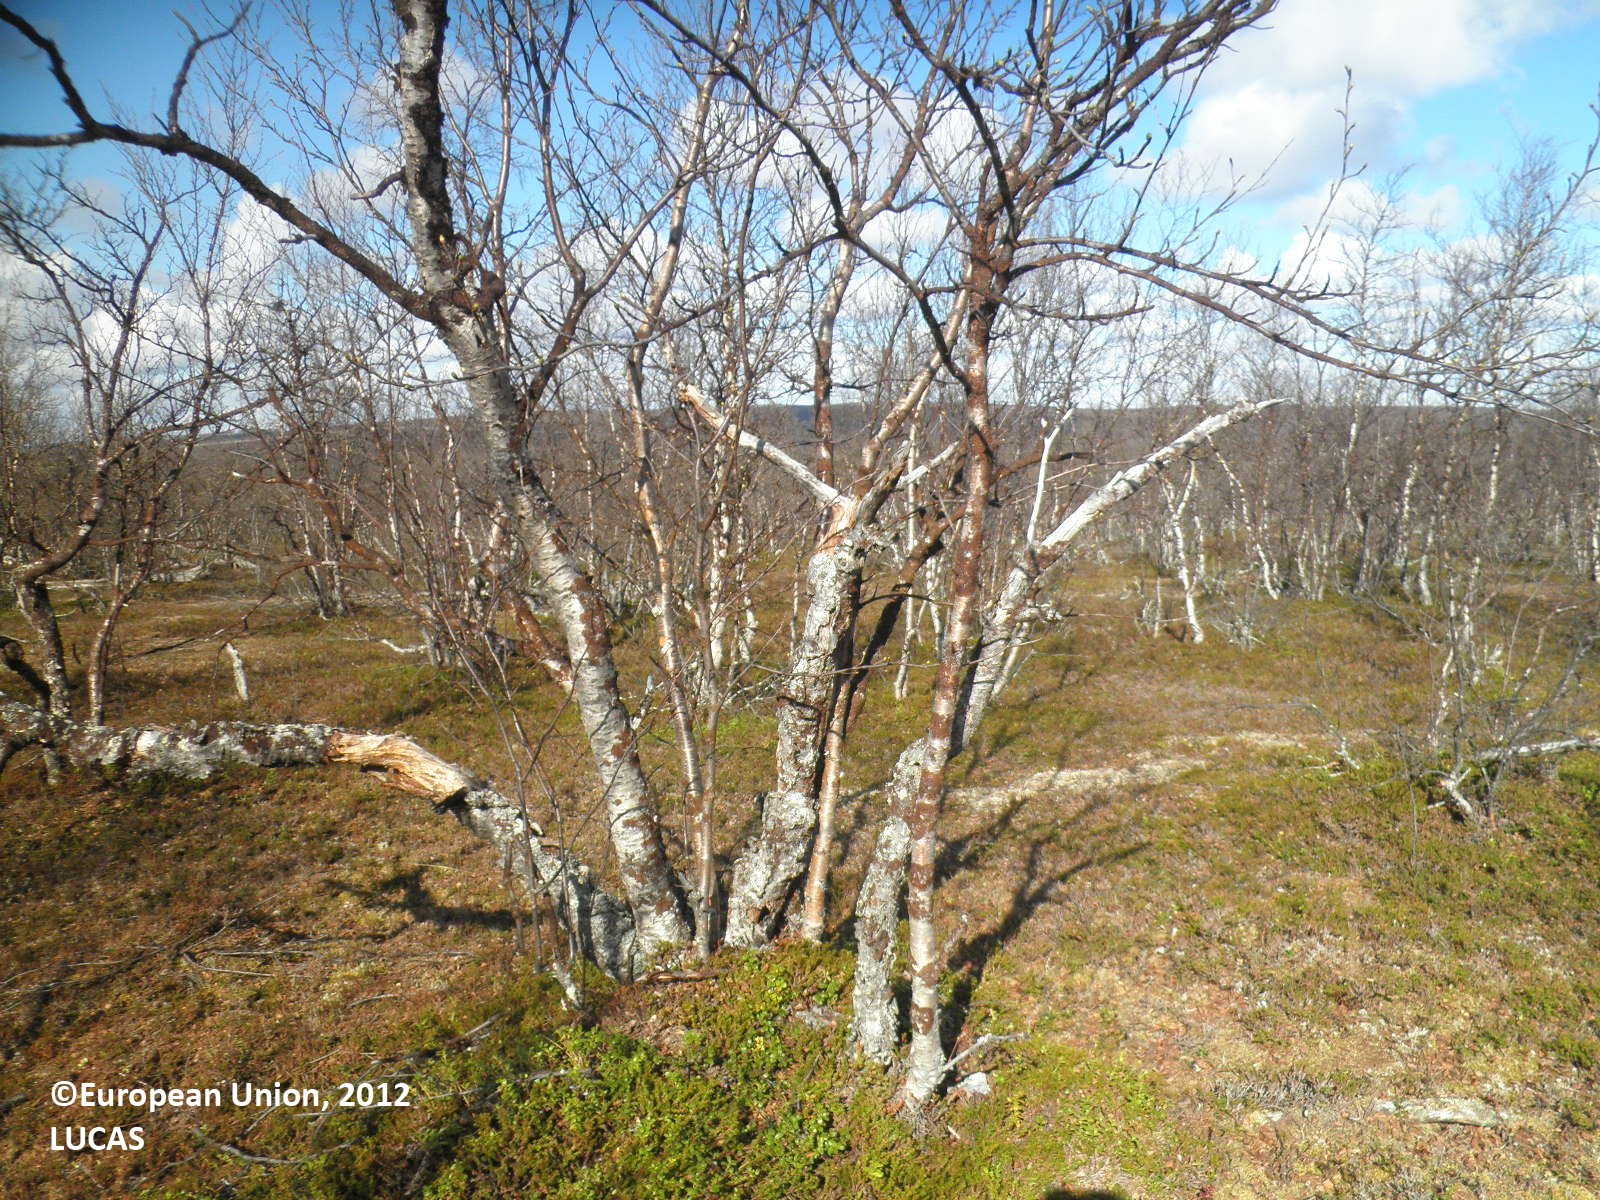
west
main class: Woodland
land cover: Broadleaved woodland
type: boreal forest
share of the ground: > 75 %
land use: Forestry
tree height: > 5 m
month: May
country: FI
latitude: 69.5095
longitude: 27.2295
